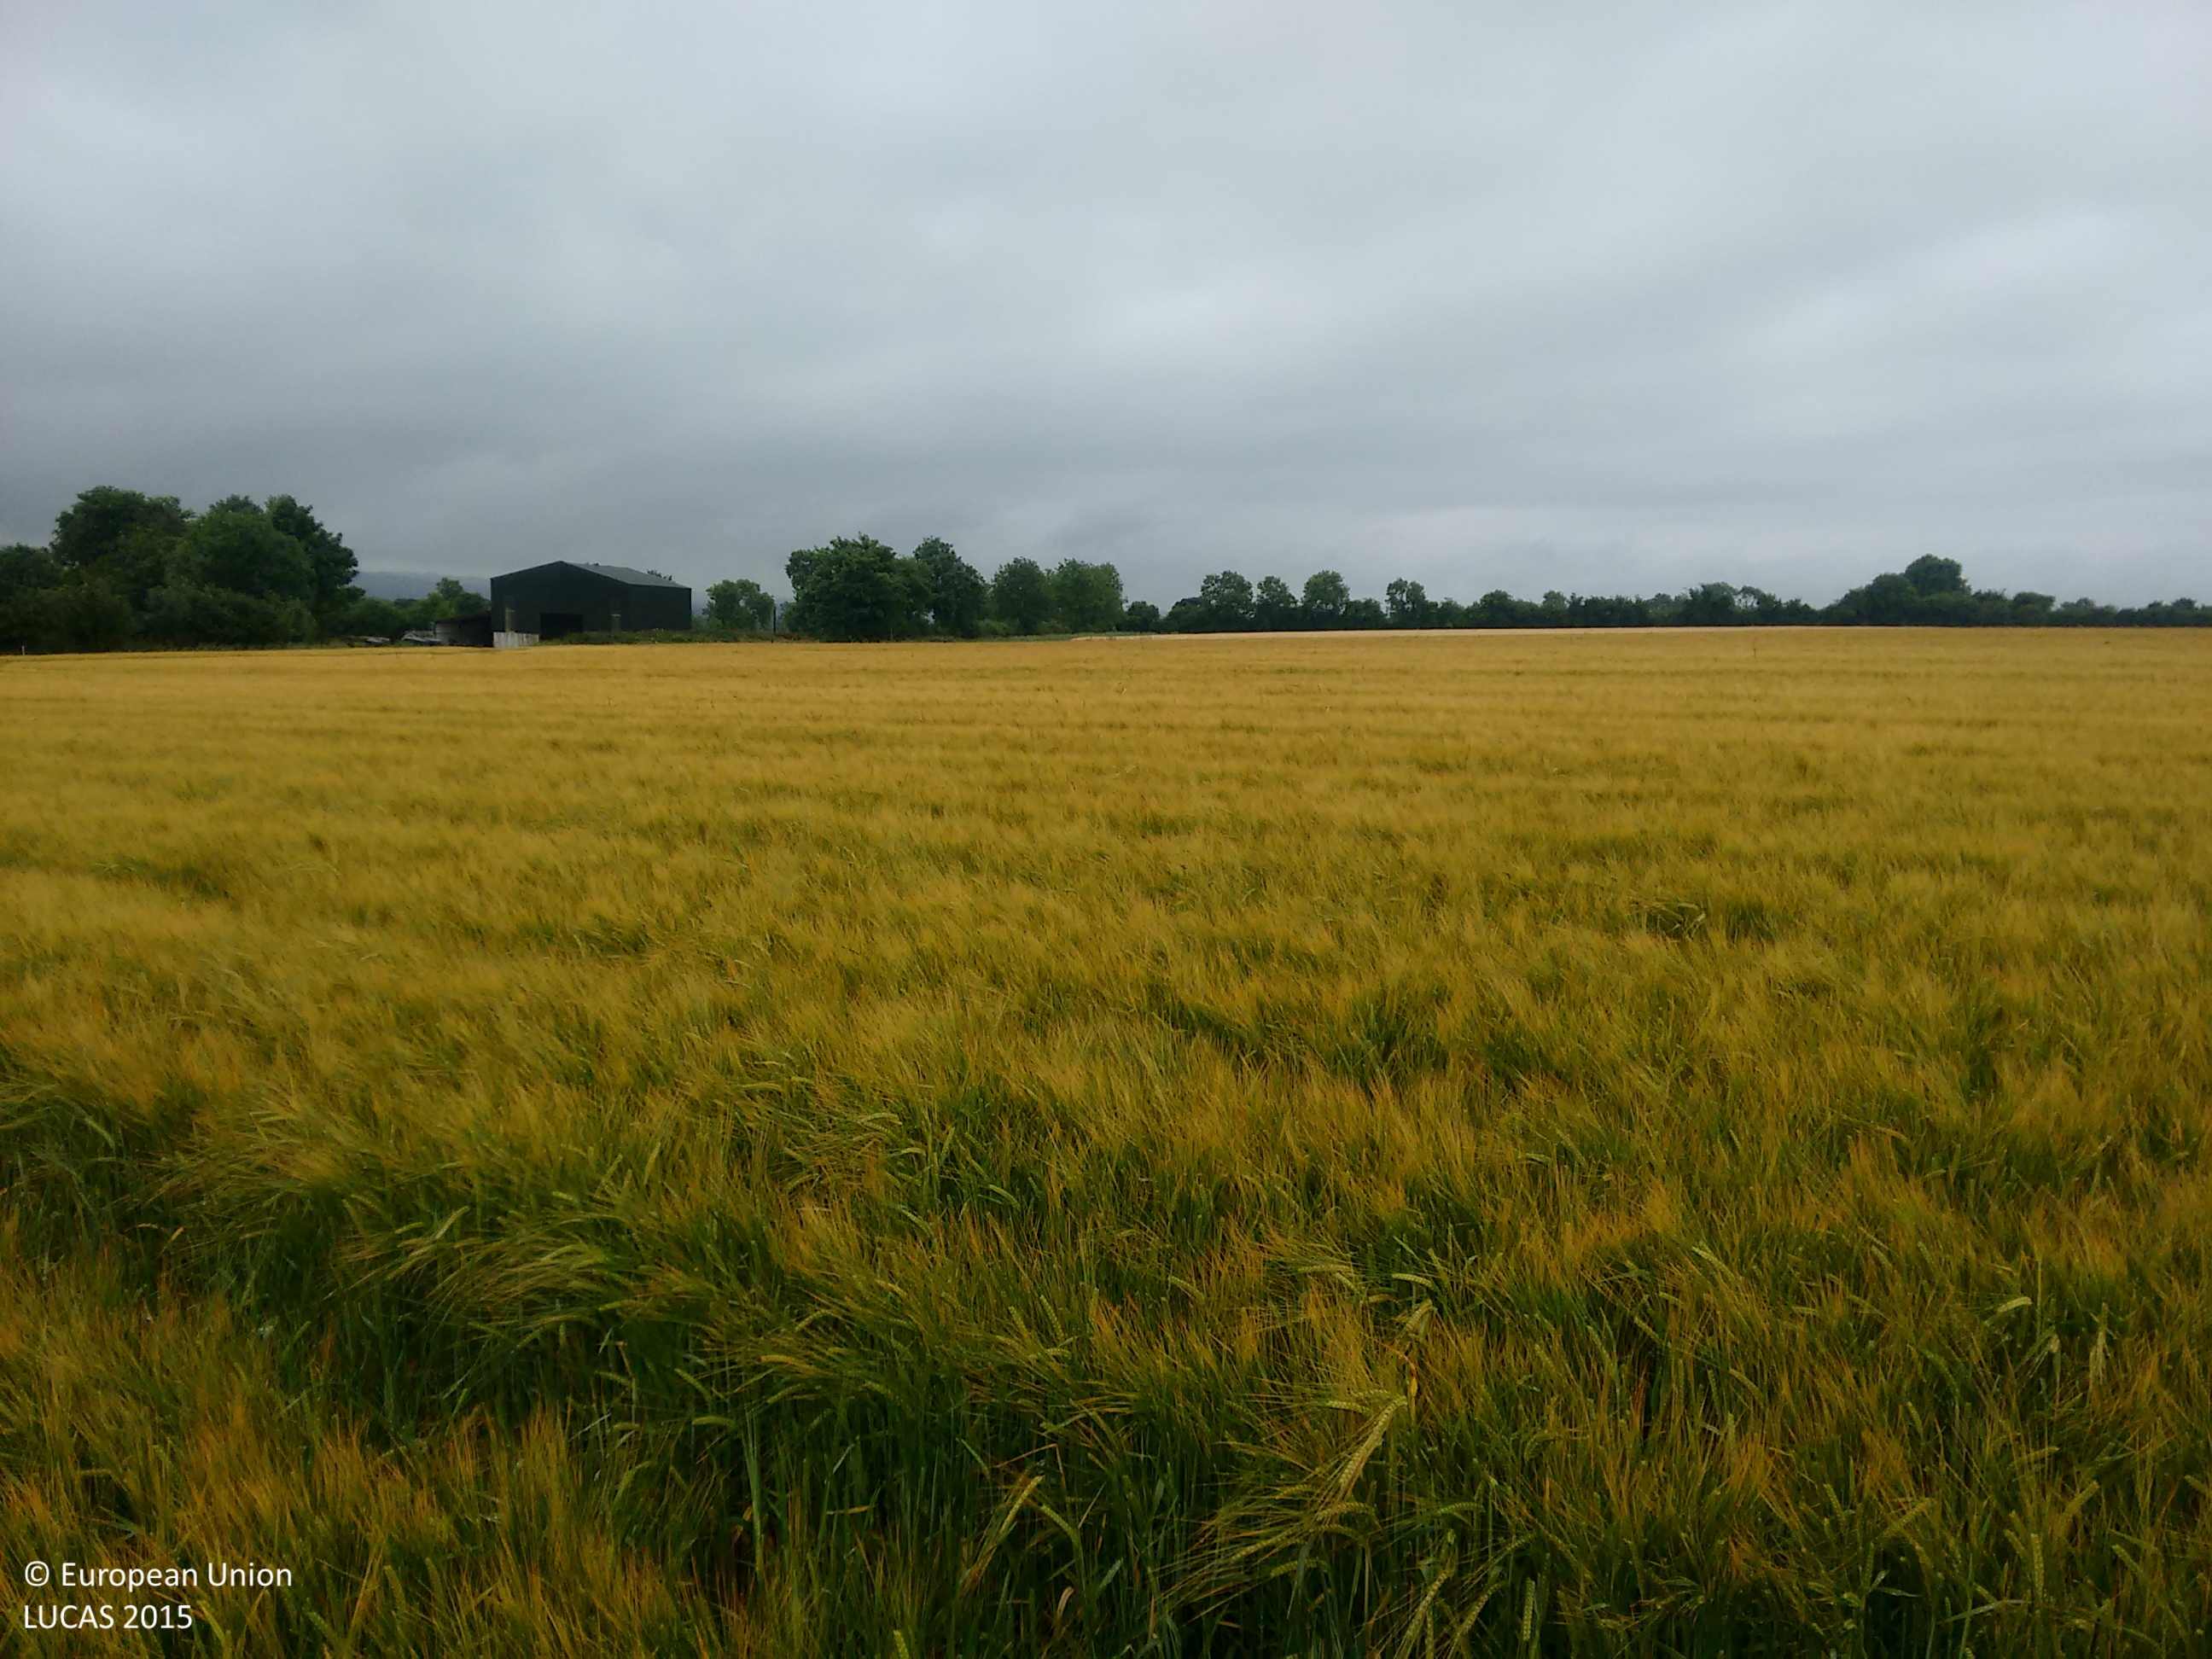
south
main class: Cropland
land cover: Barley
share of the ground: > 75 %
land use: Agriculture (excluding fallow land and kitchen gardens)
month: July
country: IE
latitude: 52.5035
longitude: -7.2244
